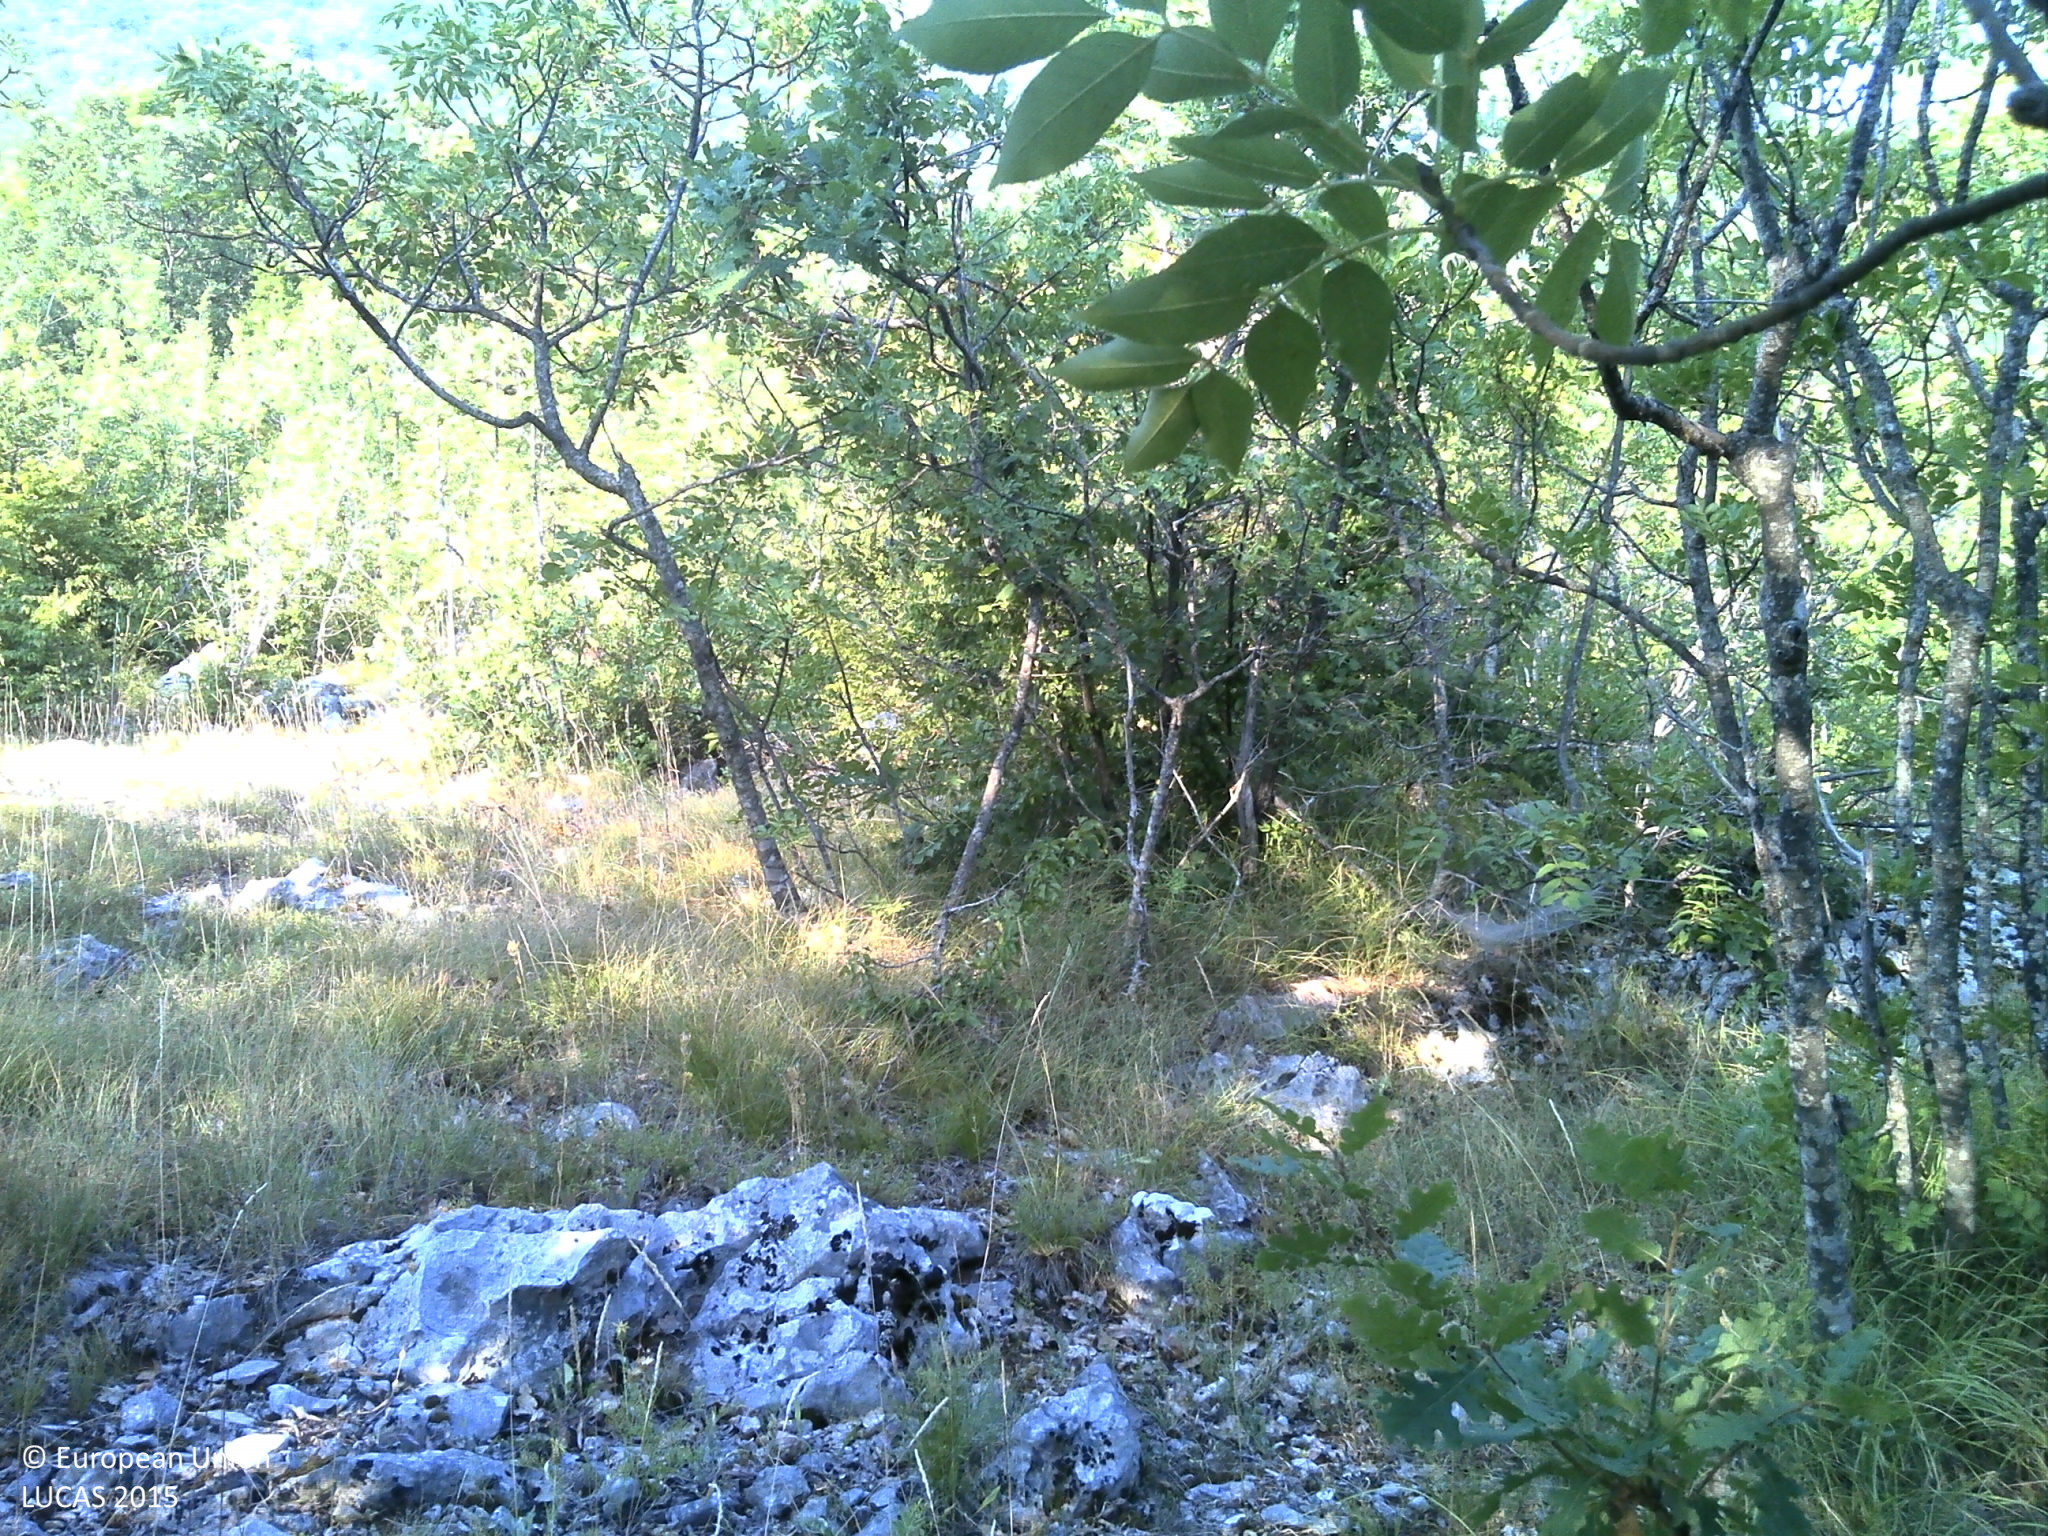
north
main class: Woodland
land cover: Broadleaved woodland
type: thermophilous deciduous forest
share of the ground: 50 - 75 %
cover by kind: broadleaved forest trees 60 %, herbaceous plants 20 %, shrubs 15 %, consolidated bare surface 5 %
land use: Semi-natural and natural areas not in use
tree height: > 5 m
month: July
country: HR
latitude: 43.3658
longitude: 17.0869
